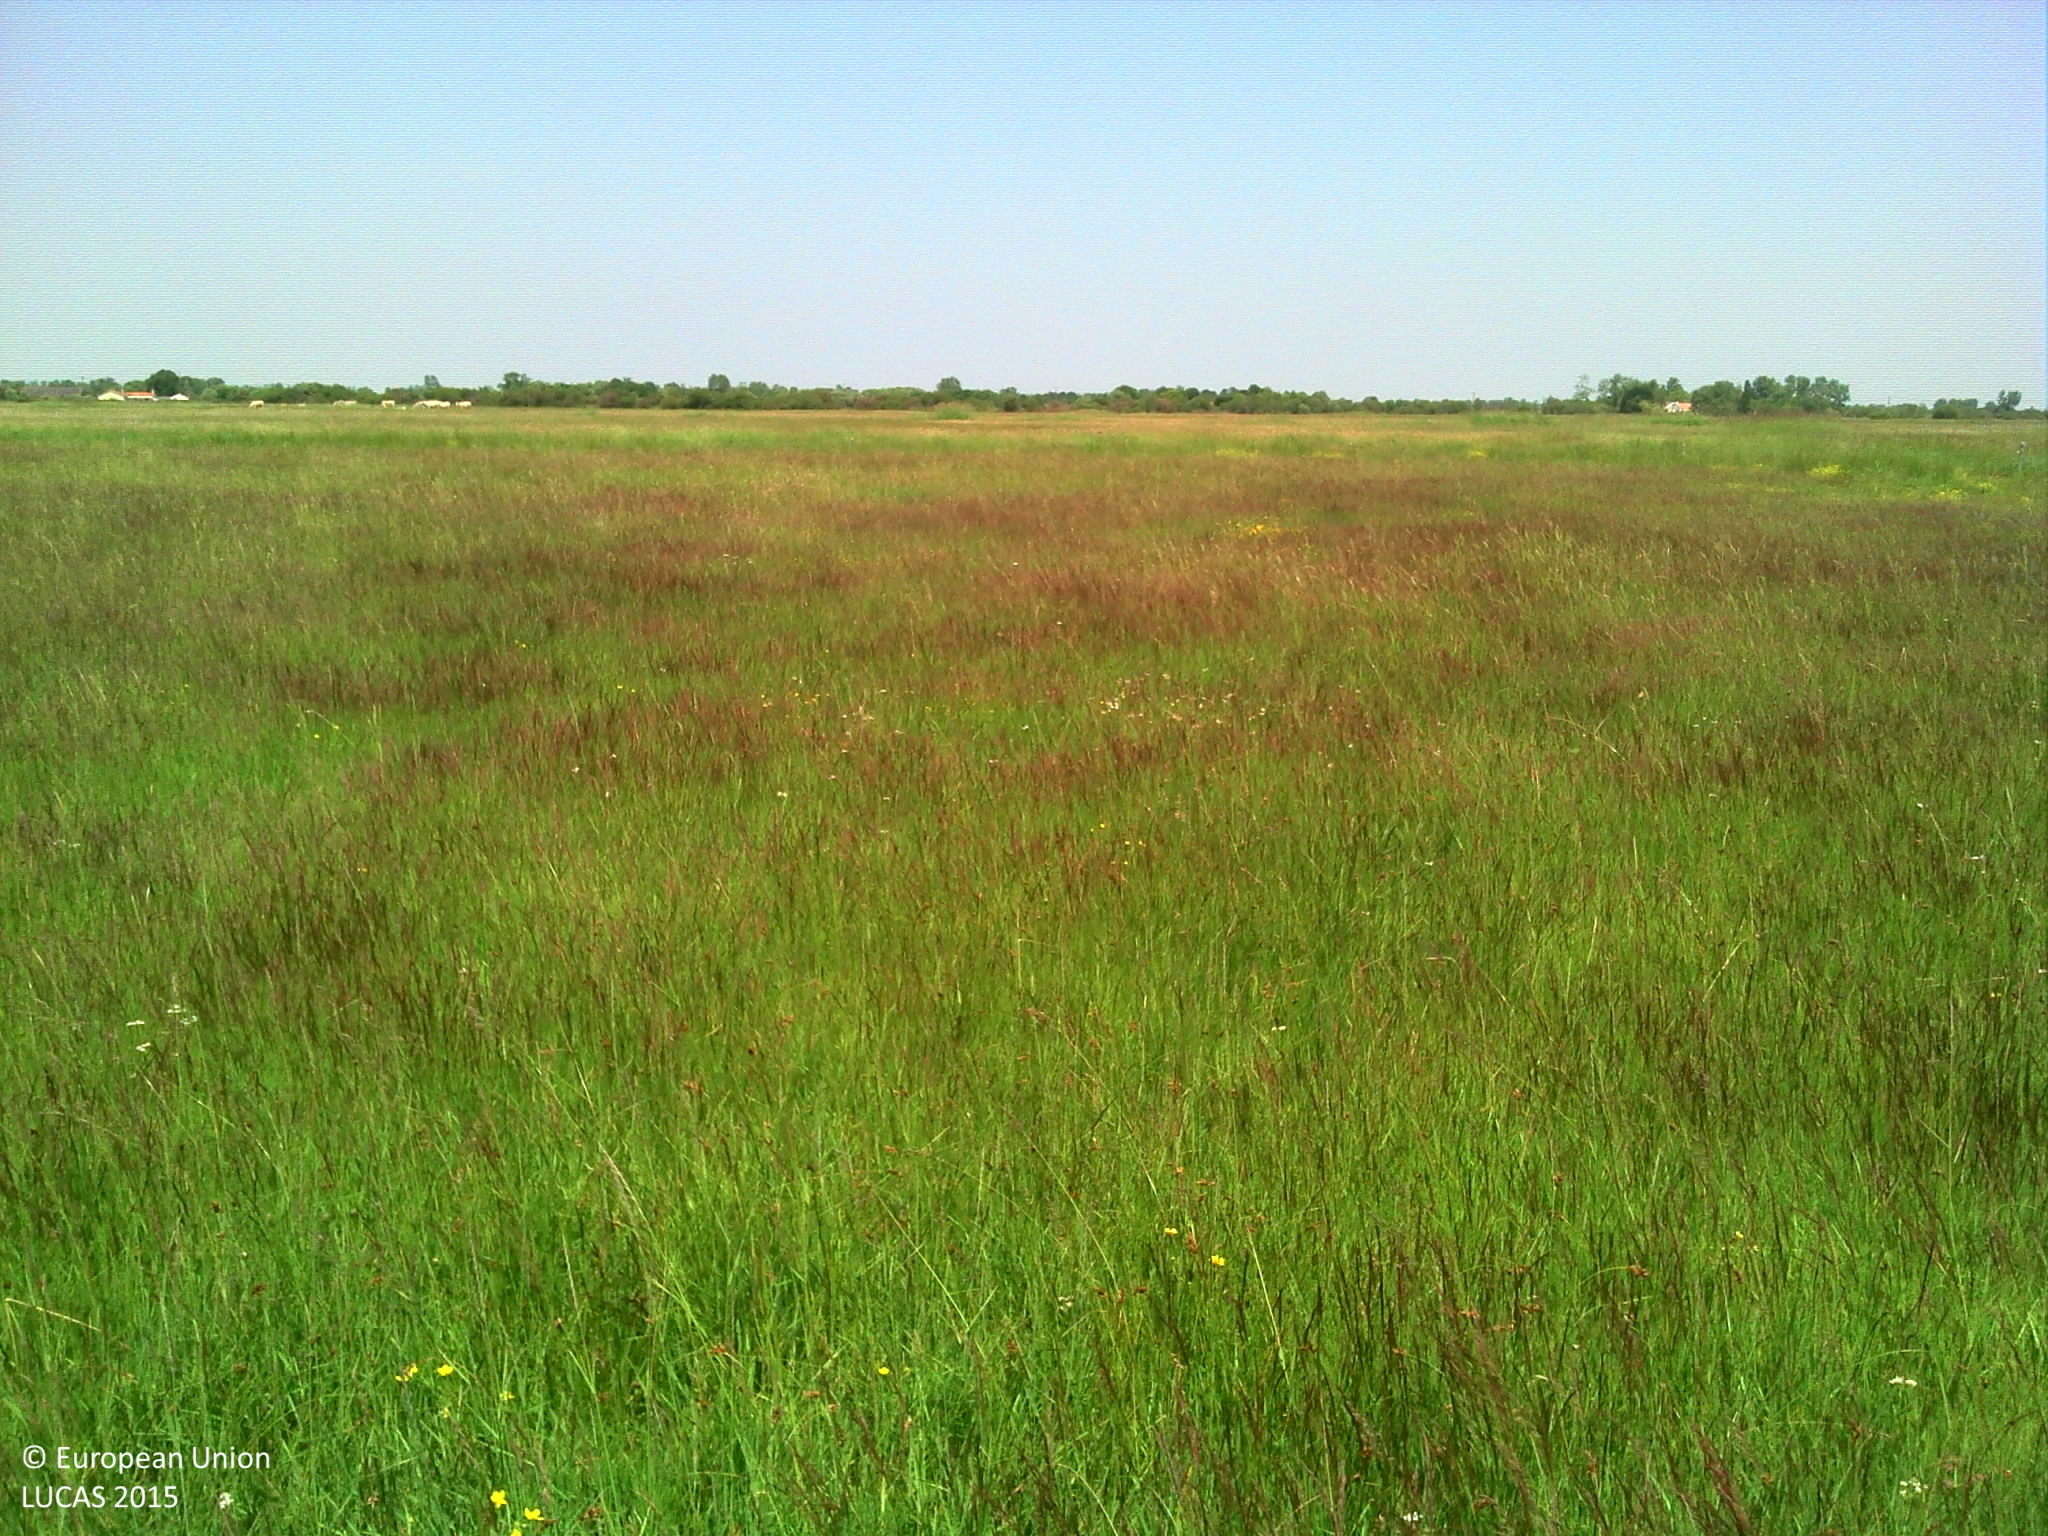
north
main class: Grassland
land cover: Grassland without tree/shrub cover
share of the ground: > 75 %
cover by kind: herbaceous plants 100 %
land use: Agriculture (excluding fallow land and kitchen gardens)
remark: Temporary flooded
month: June
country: FR
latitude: 46.8060
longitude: -1.9568
